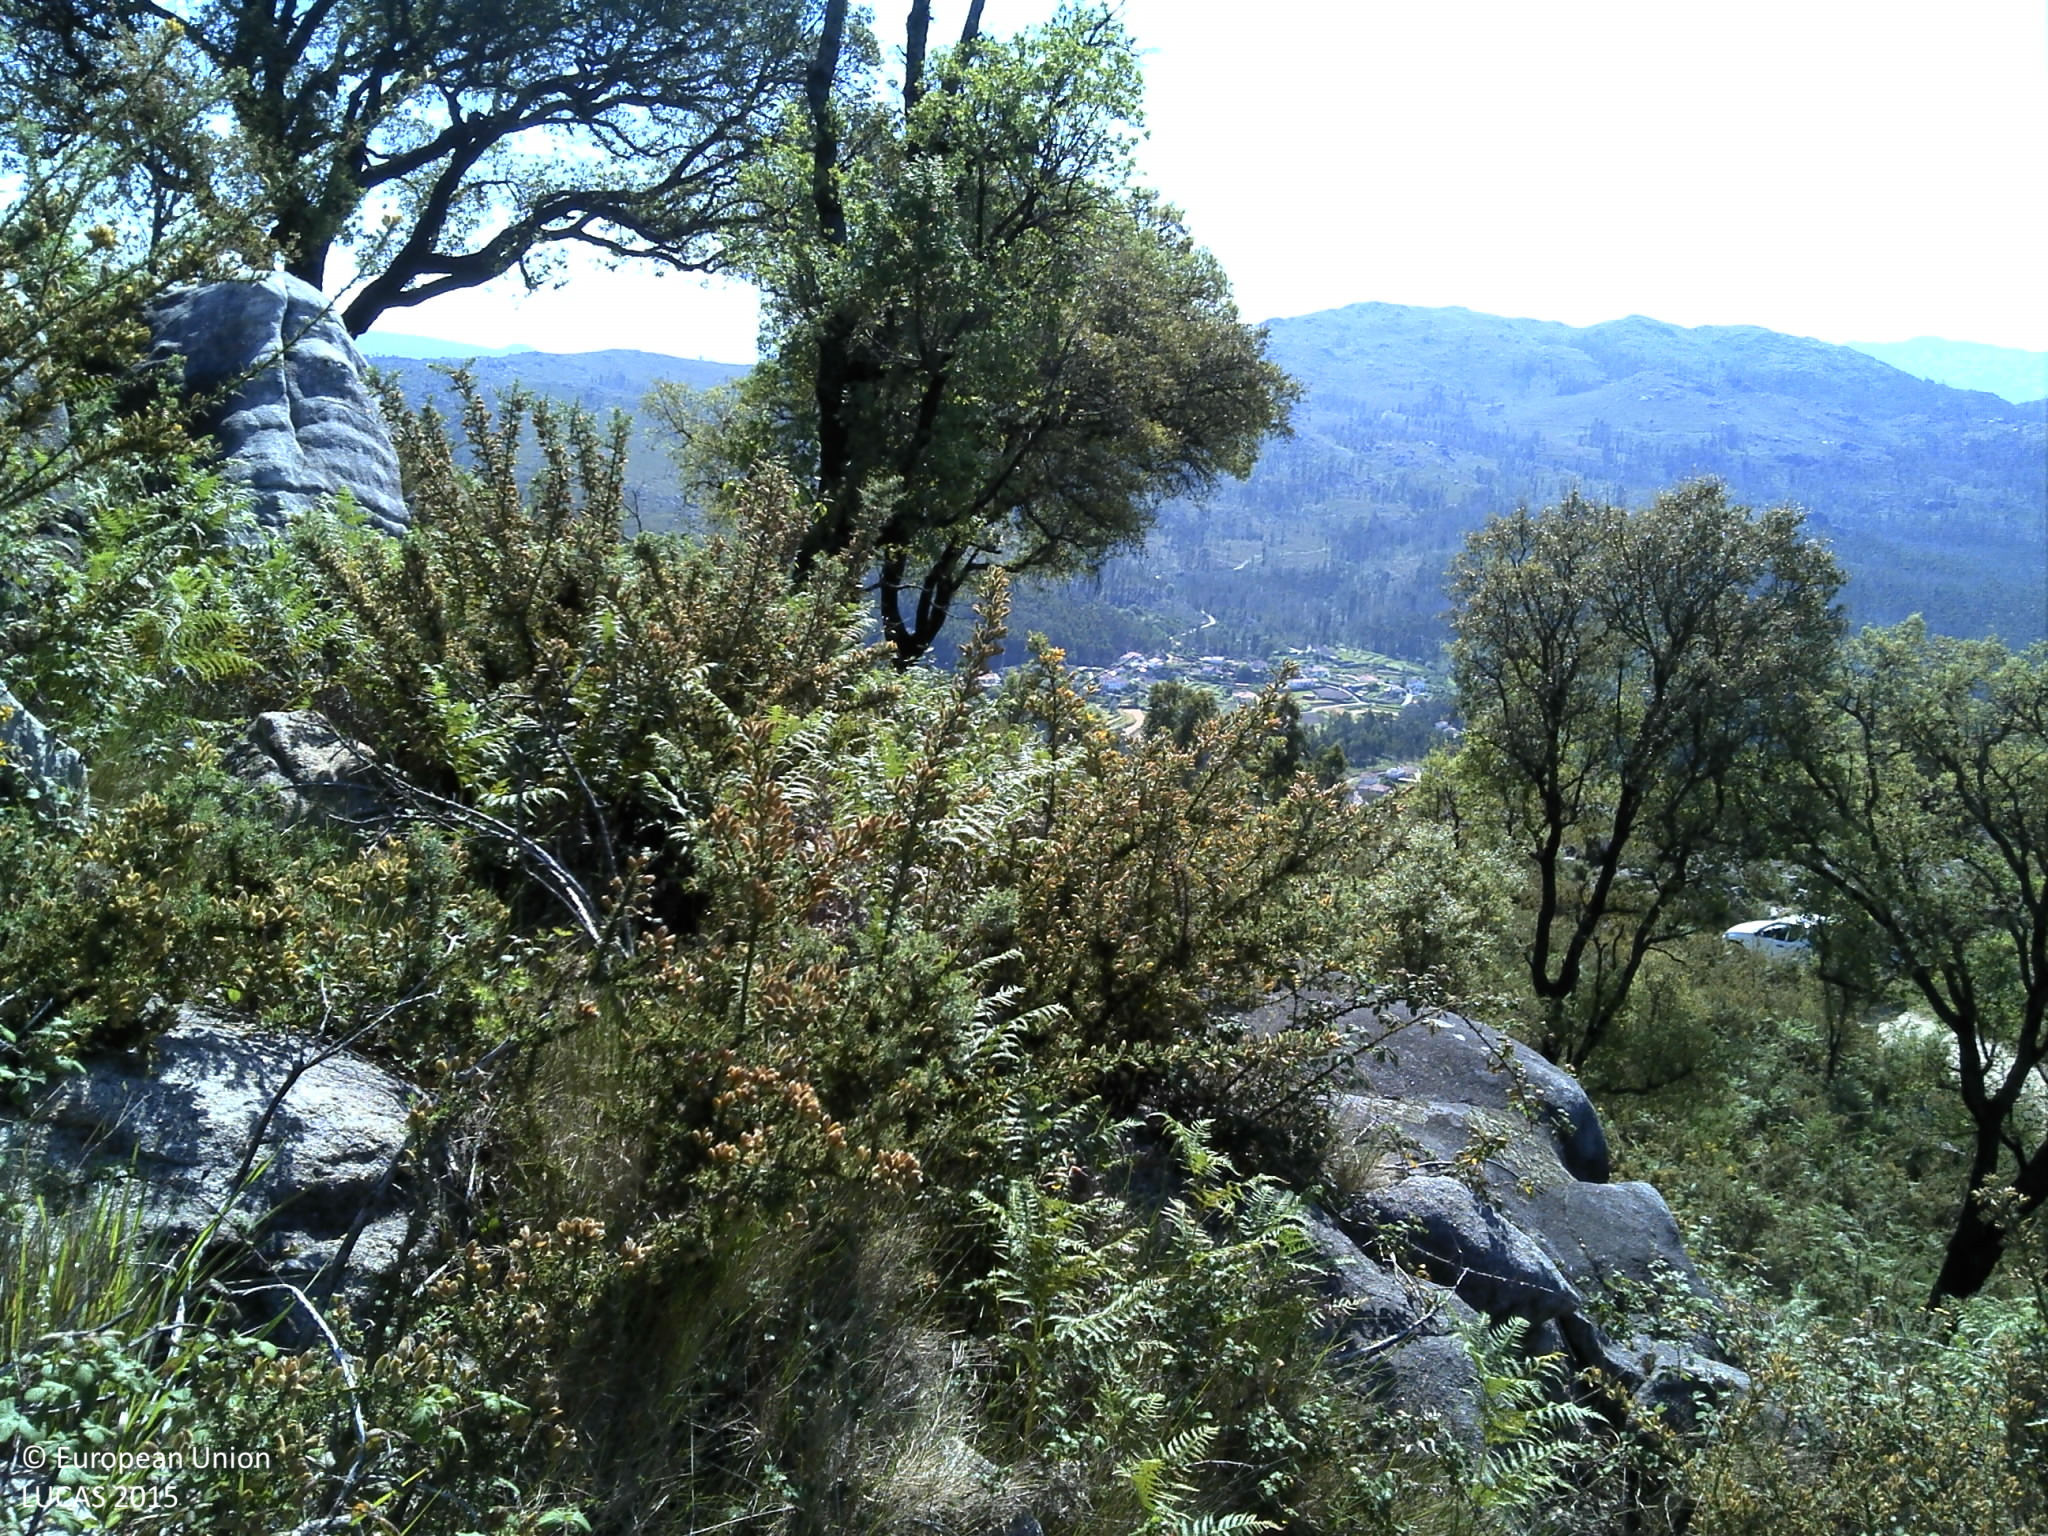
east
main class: Shrubland
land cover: Shrubland without tree cover
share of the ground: > 75 %
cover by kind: shrubs 80 %, unconsolidated bare surface 20 %
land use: Semi-natural and natural areas not in use
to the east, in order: Shrubland without tree cover; Shrubland with sparse tree cover; Shrubland without tree cover; Rock outcrops; Shrubland without tree cover; Rock outcrops; Shrubland without tree cover; Broadleaved woodland; Tracks; Shrubland with sparse tree cover; Broadleaved woodland
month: May
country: PT
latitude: 41.7623
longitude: -8.8003
